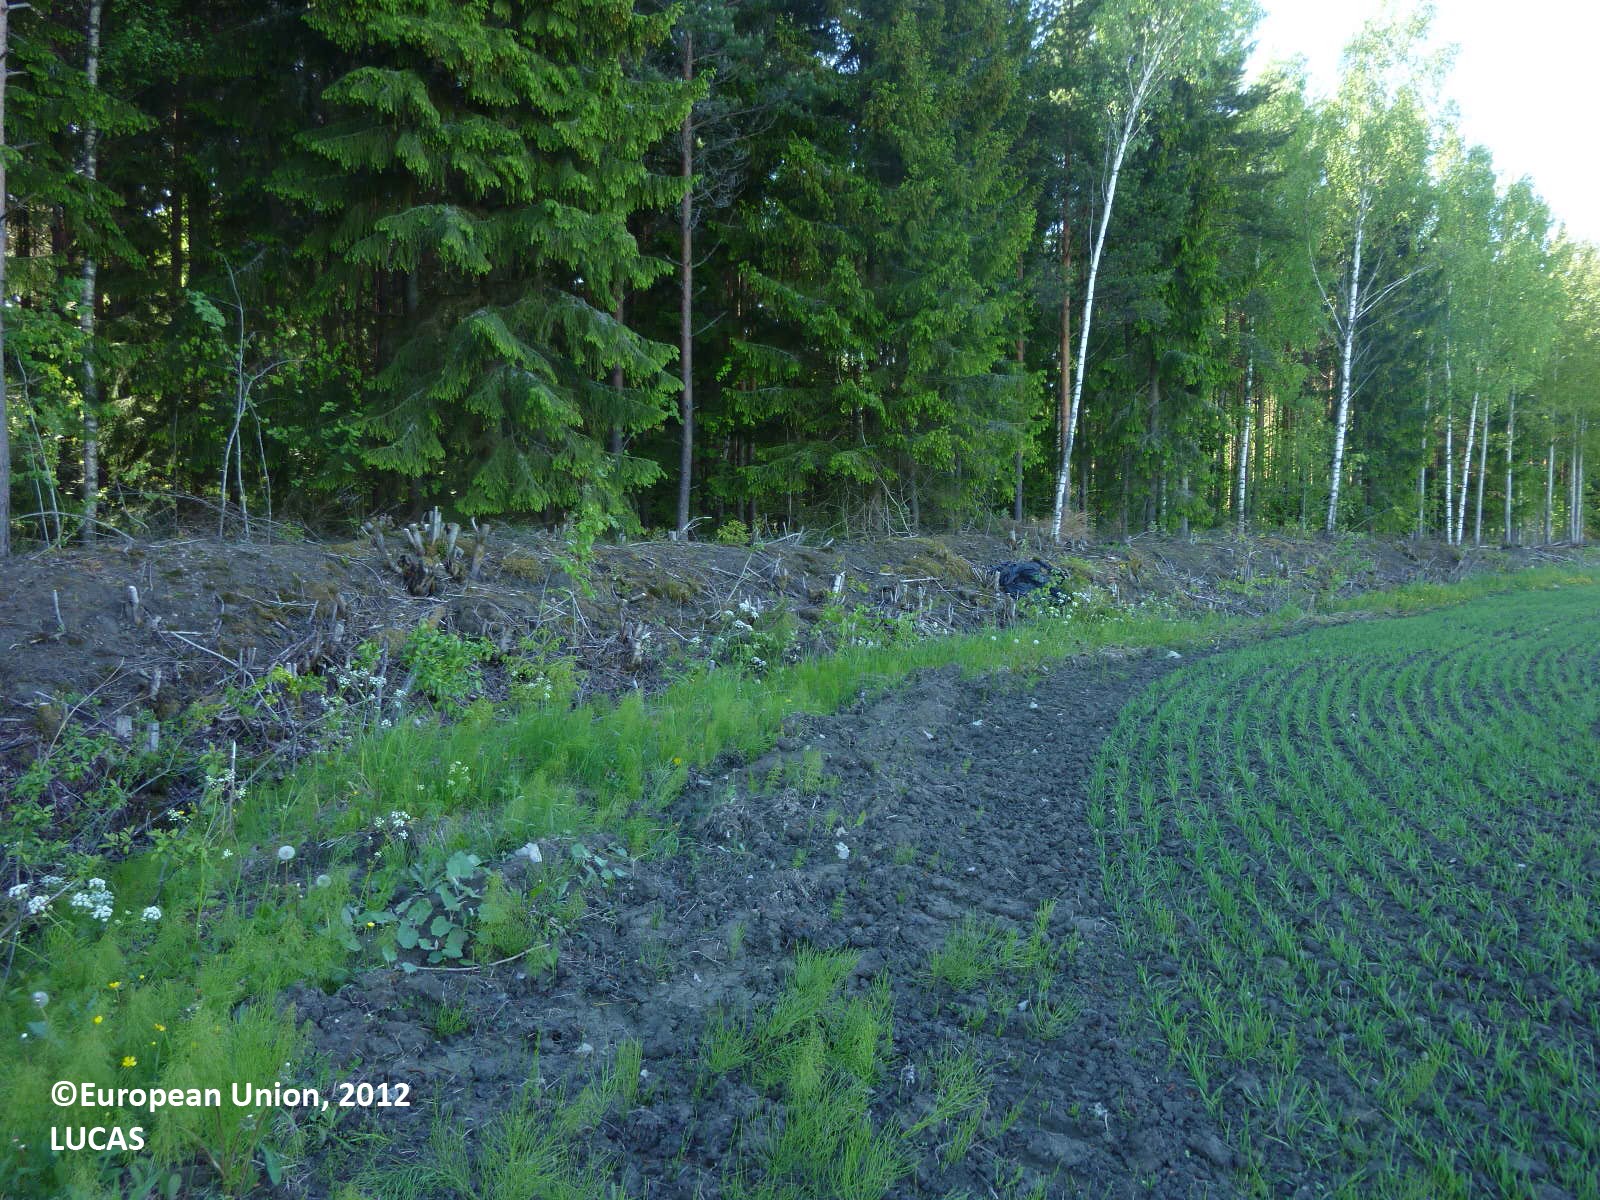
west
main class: Cropland
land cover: Common wheat
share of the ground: > 75 %
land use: Agriculture (excluding fallow land and kitchen gardens)
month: June
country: FI
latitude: 60.3377
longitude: 22.6637
